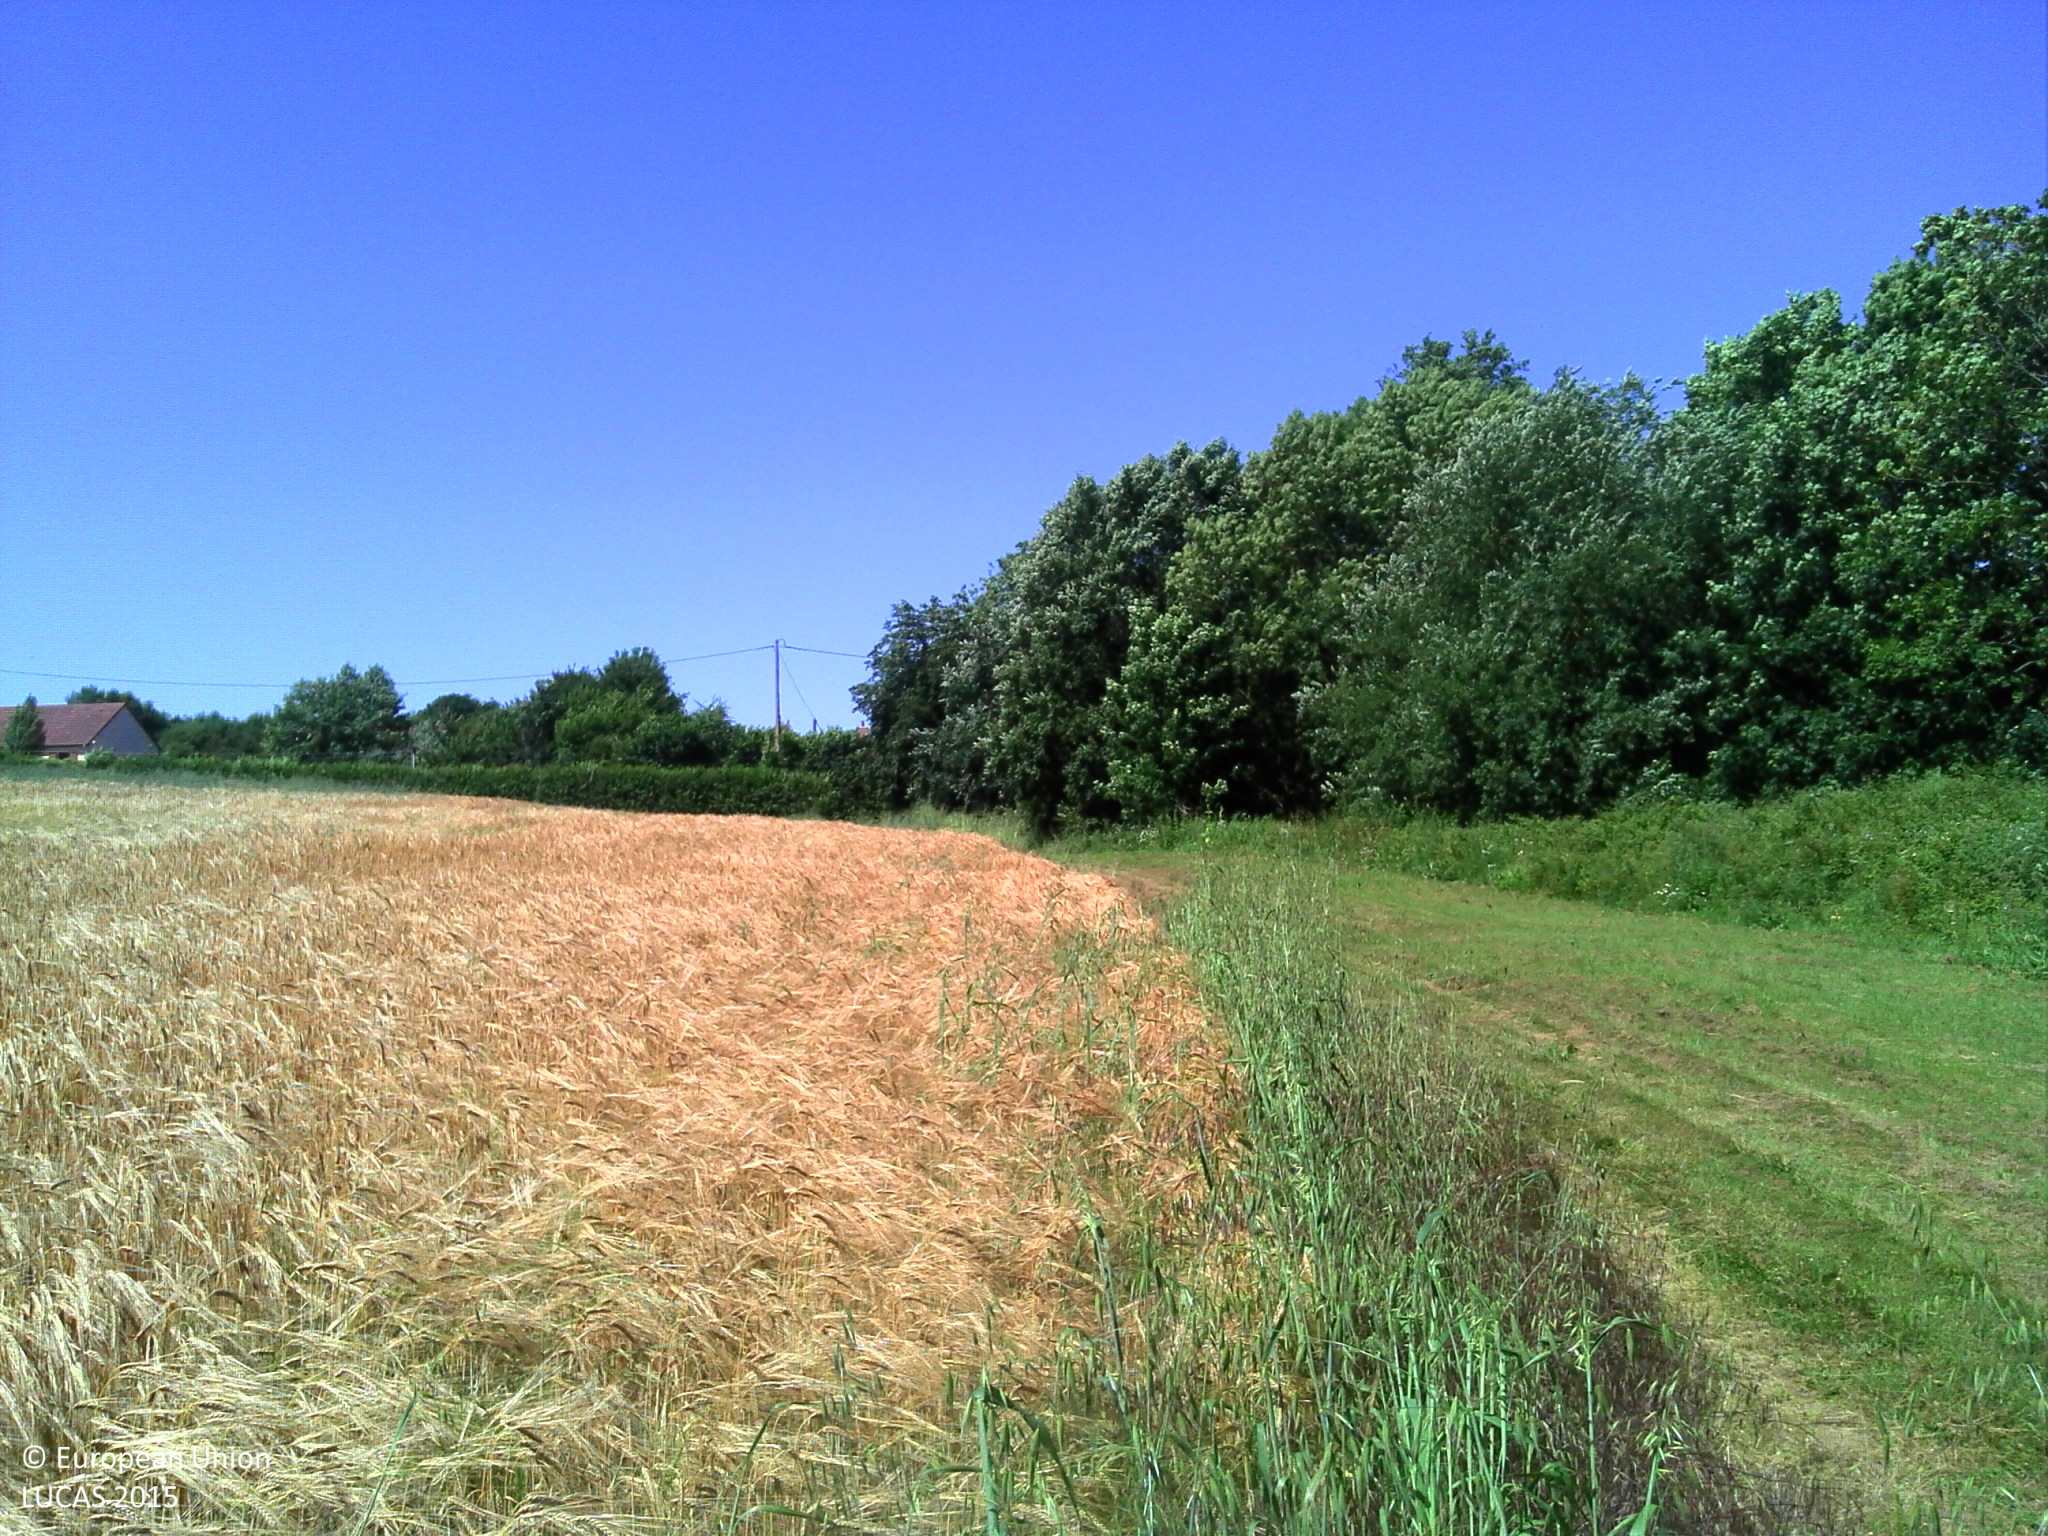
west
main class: Cropland
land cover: Barley
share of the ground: > 75 %
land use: Agriculture (excluding fallow land and kitchen gardens)
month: June
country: FR
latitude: 48.9952
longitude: 0.1438
